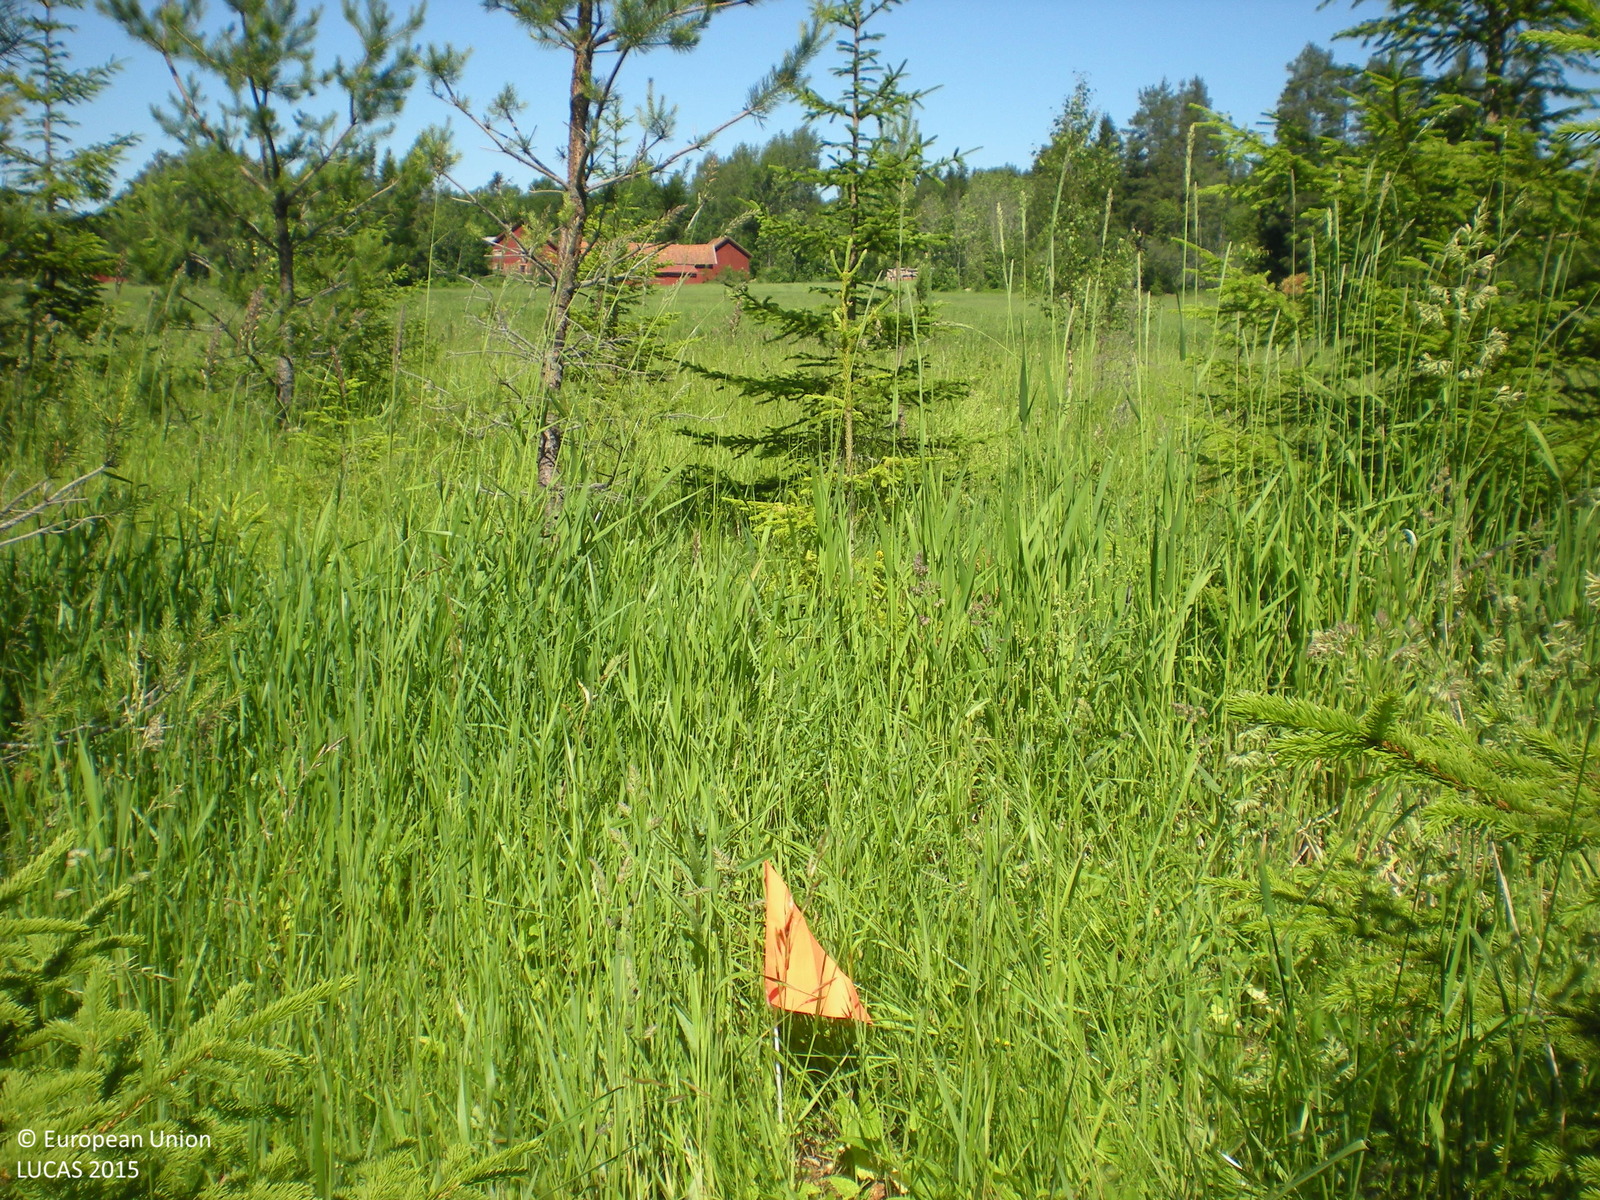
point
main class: Woodland
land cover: Other coniferous woodland
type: boreal forest
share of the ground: 10 - 25 %
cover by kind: herbaceous plants 65 %, coniferous forest trees 35 %
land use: Forestry
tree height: < 5 m
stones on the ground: < 10 %
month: July
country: SE
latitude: 60.4916
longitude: 17.7636
